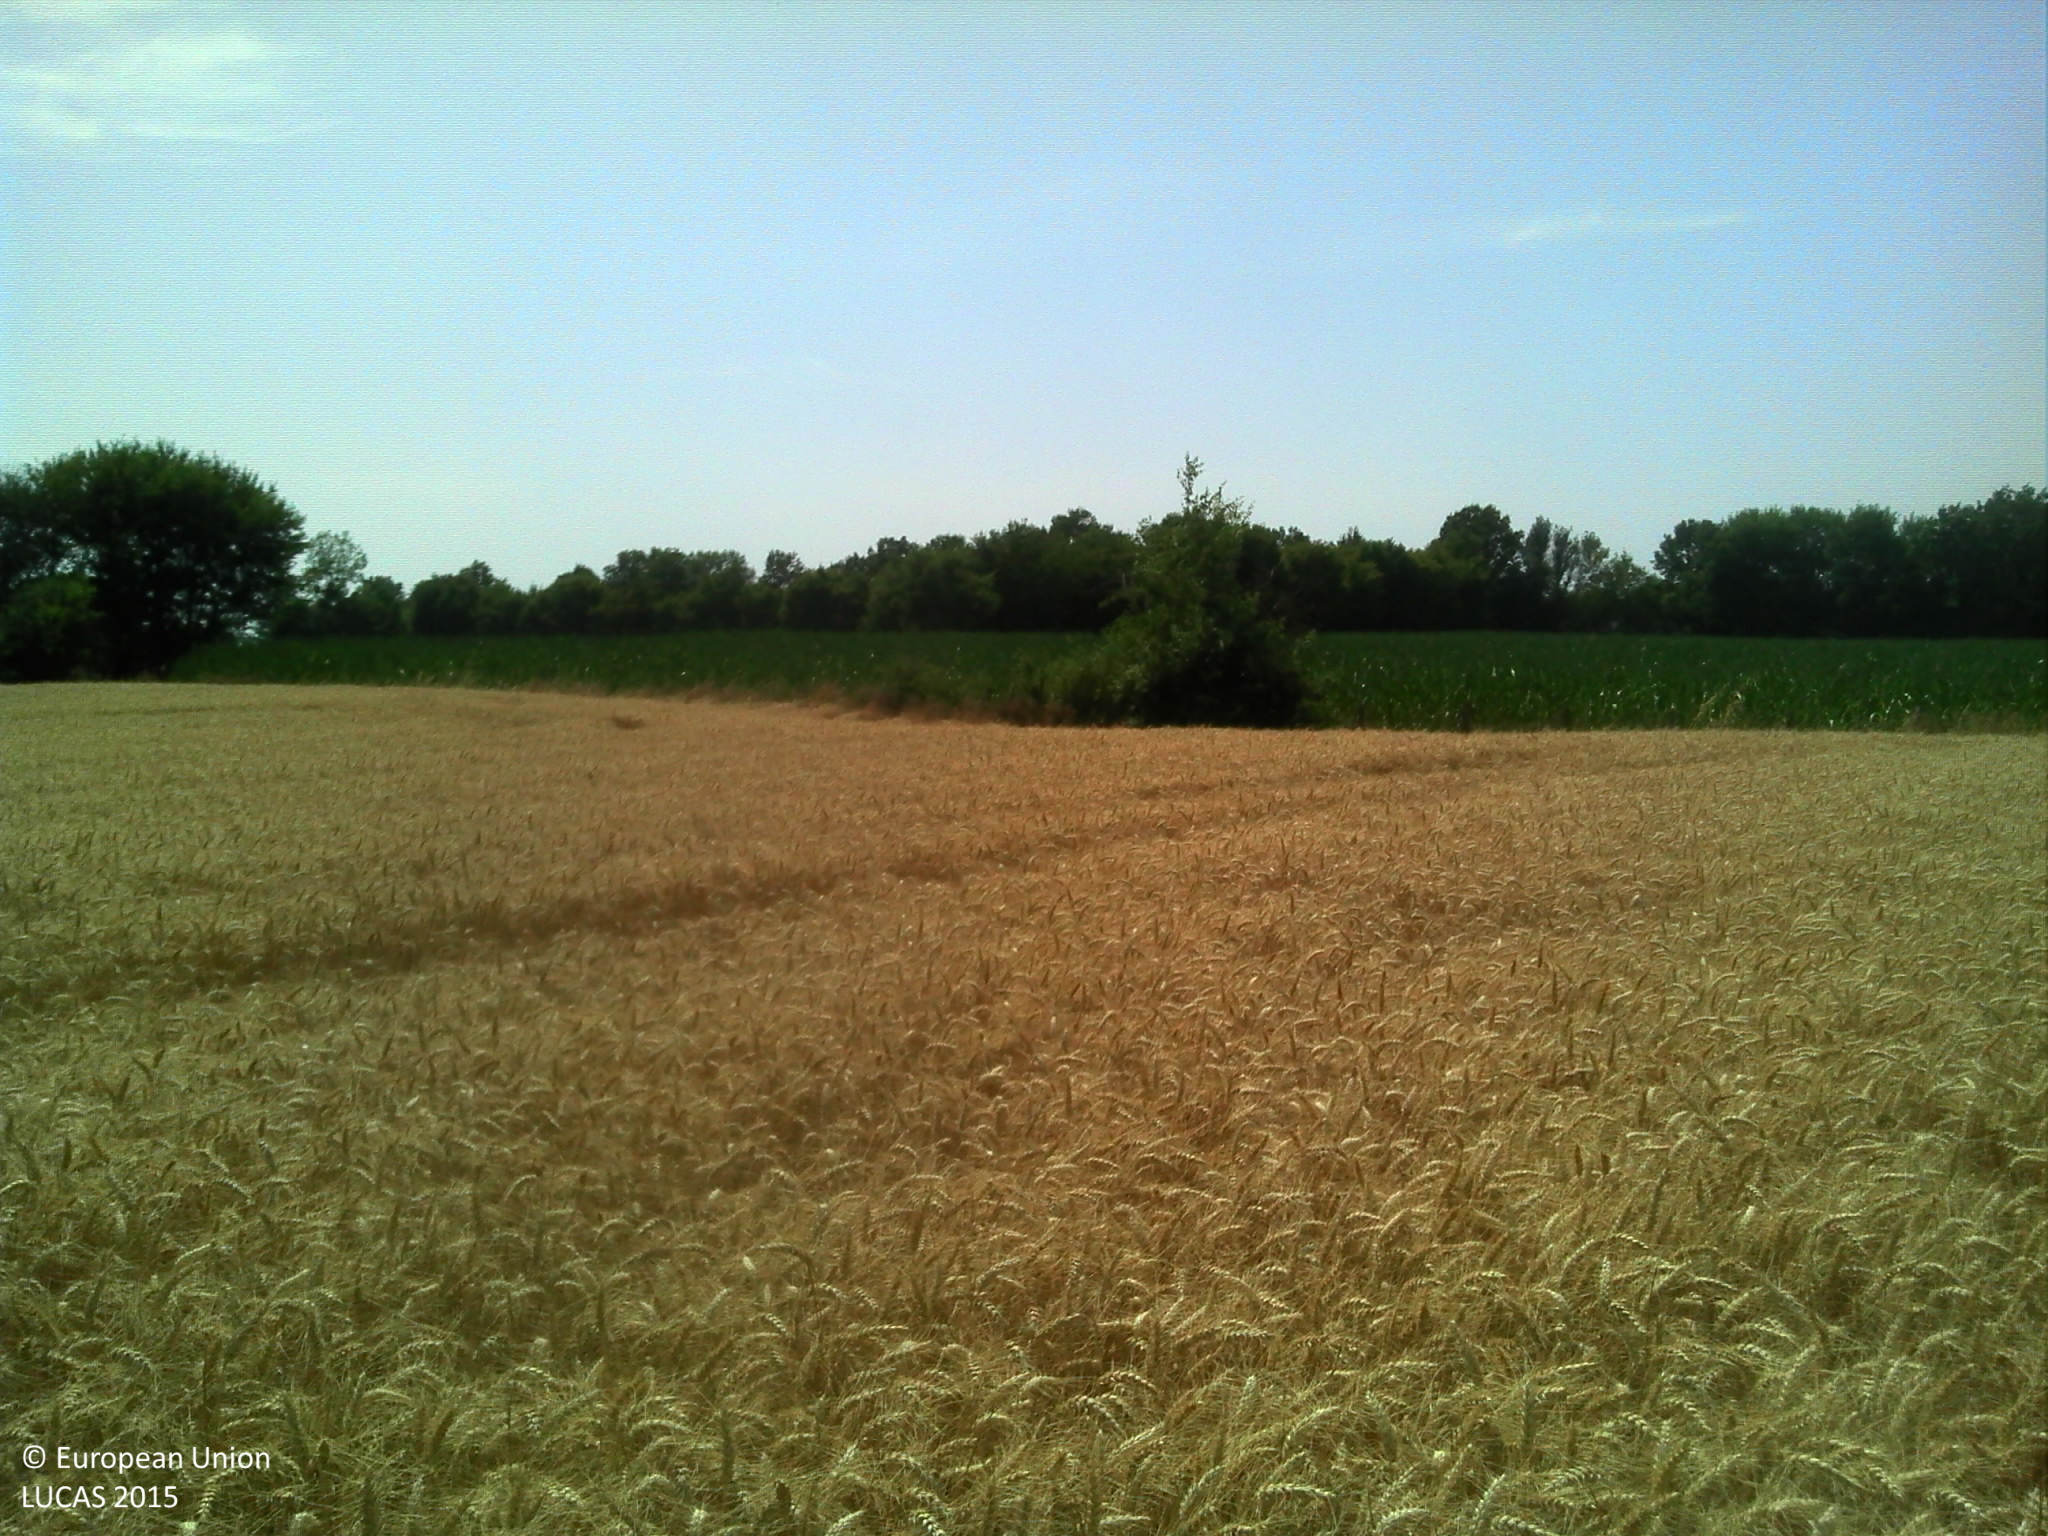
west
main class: Cropland
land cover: Barley
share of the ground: > 75 %
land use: Agriculture (excluding fallow land and kitchen gardens)
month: July
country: FR
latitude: 46.8250
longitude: 5.2959
